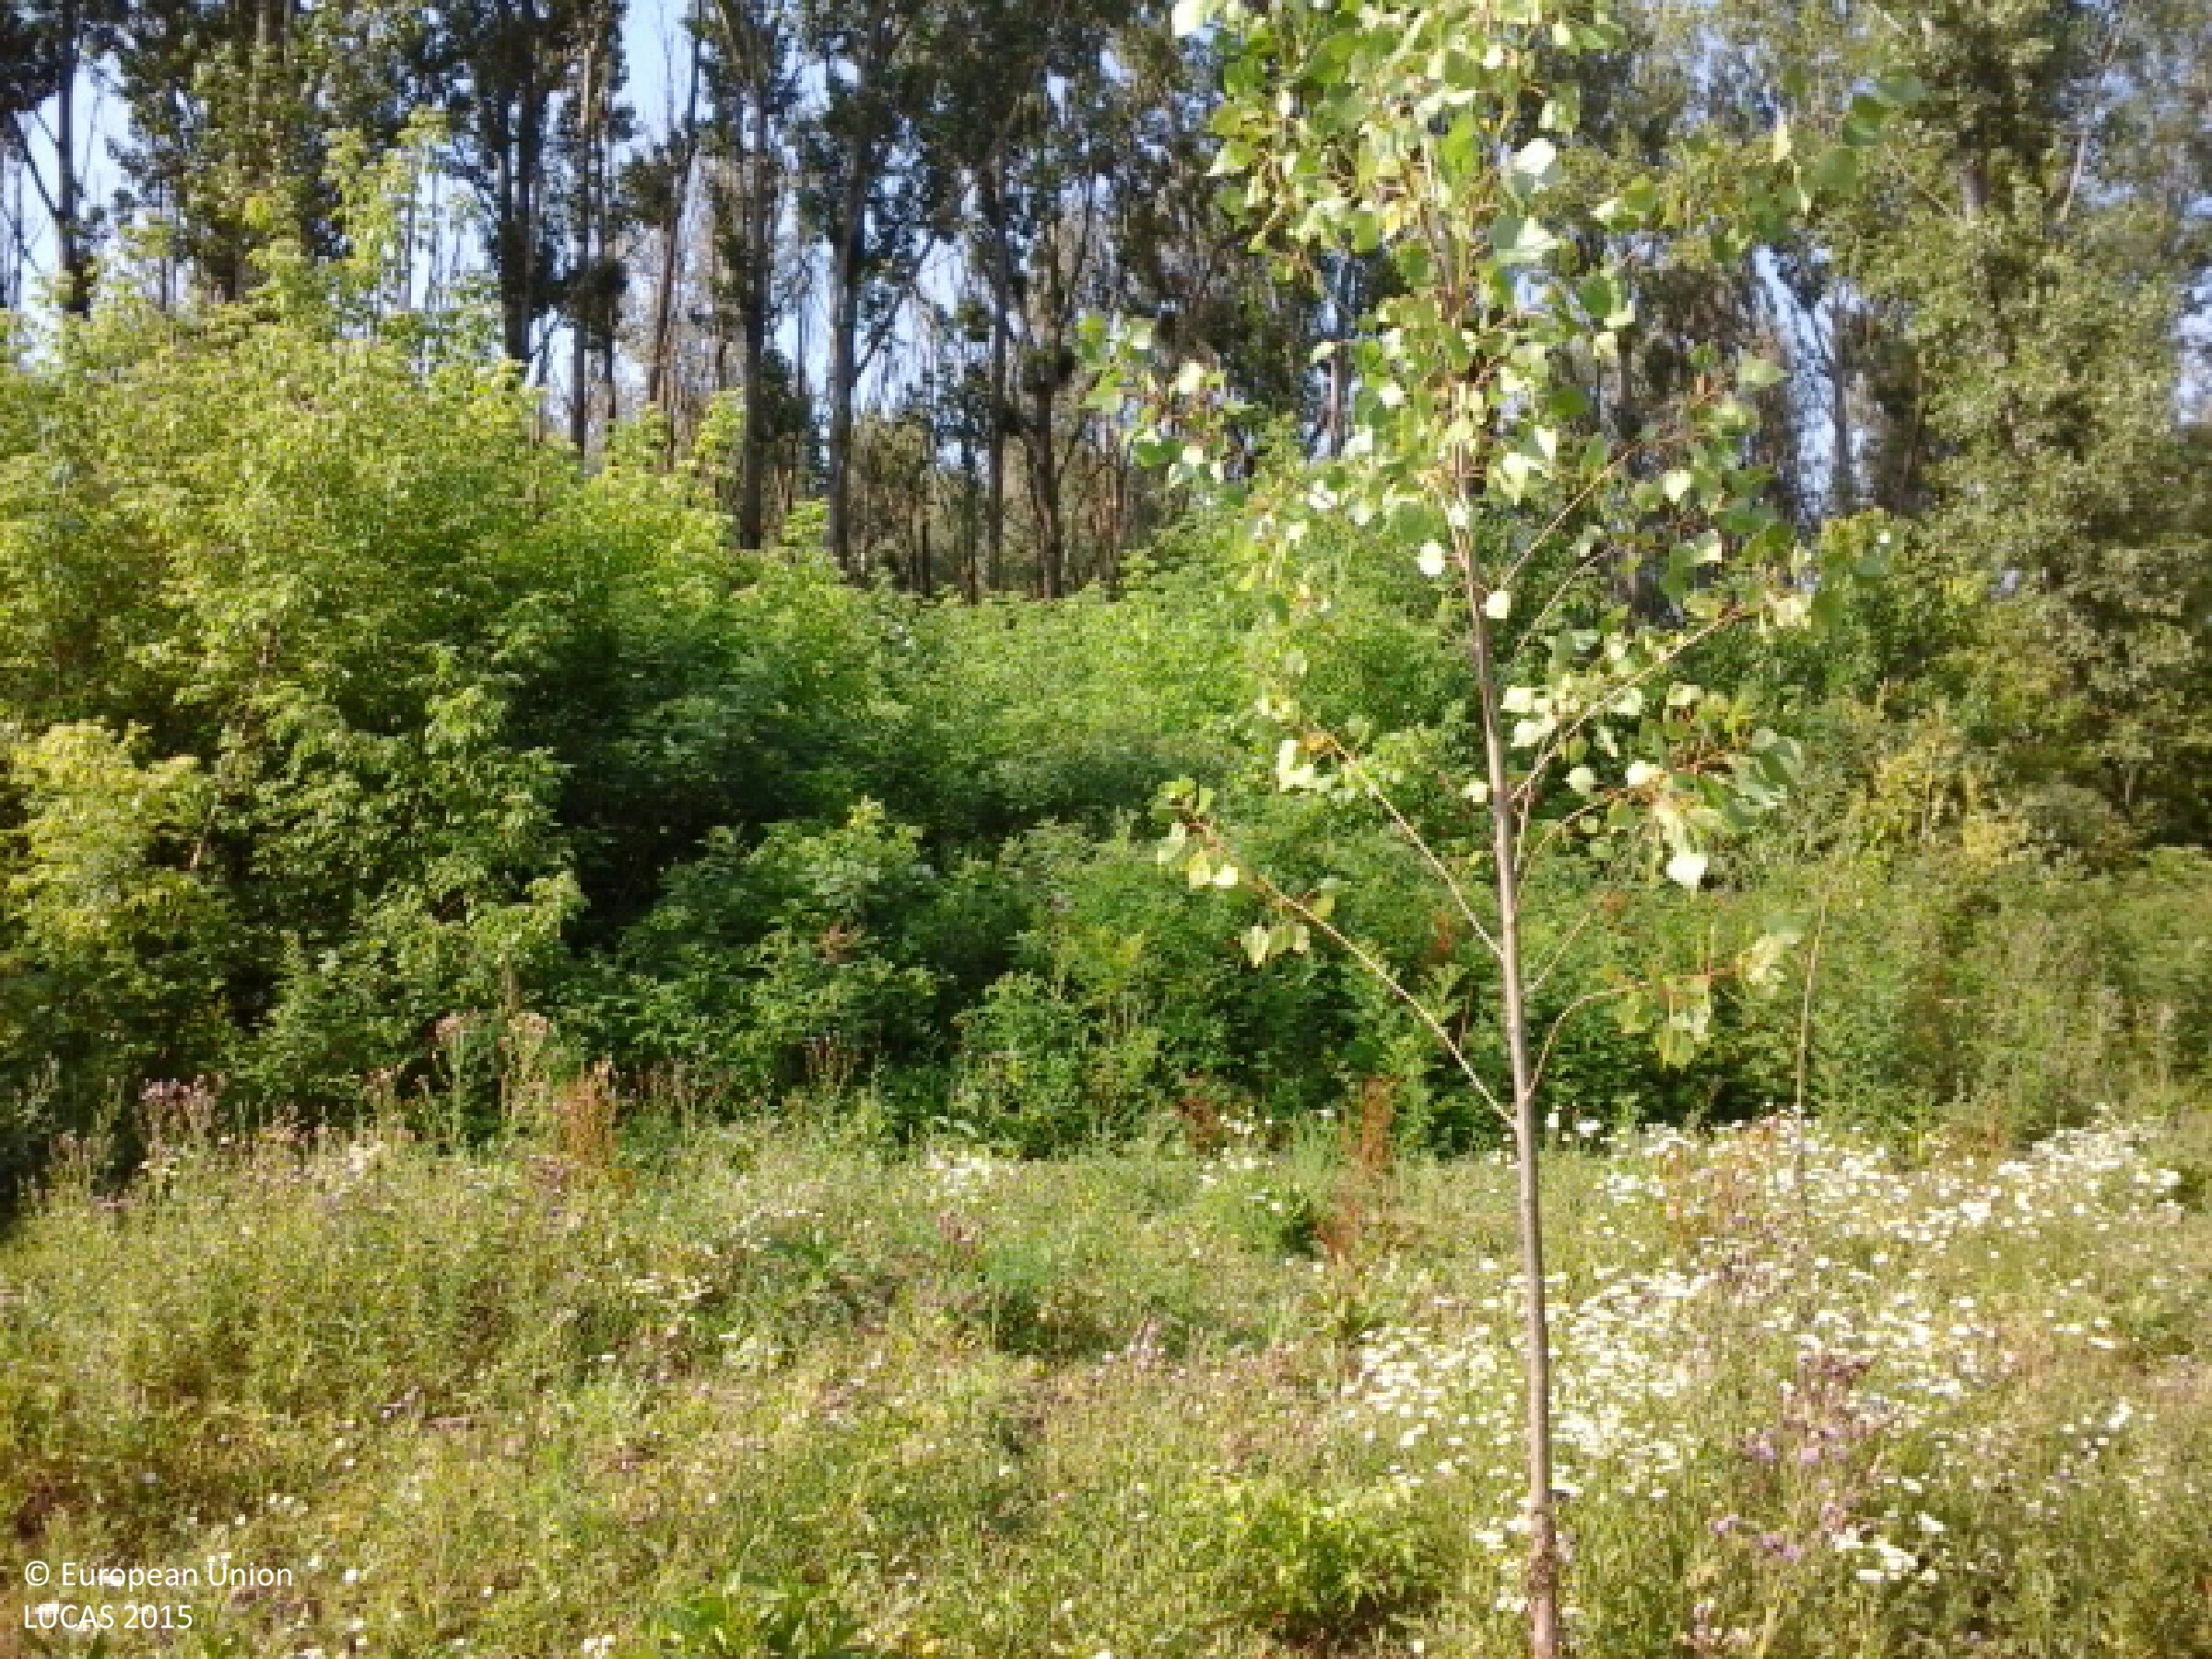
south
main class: Woodland
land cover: Broadleaved woodland
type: non-riverine alder, birch or aspen forest
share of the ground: 25 - 50 %
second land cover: Grassland without tree/shrub cover
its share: > 75 %
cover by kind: herbaceous plants 55 %, broadleaved forest trees 40 %, shrubs 5 %
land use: Forestry
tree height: < 5 m
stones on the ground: < 10 %
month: June
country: HU
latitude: 48.1938
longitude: 21.7398
